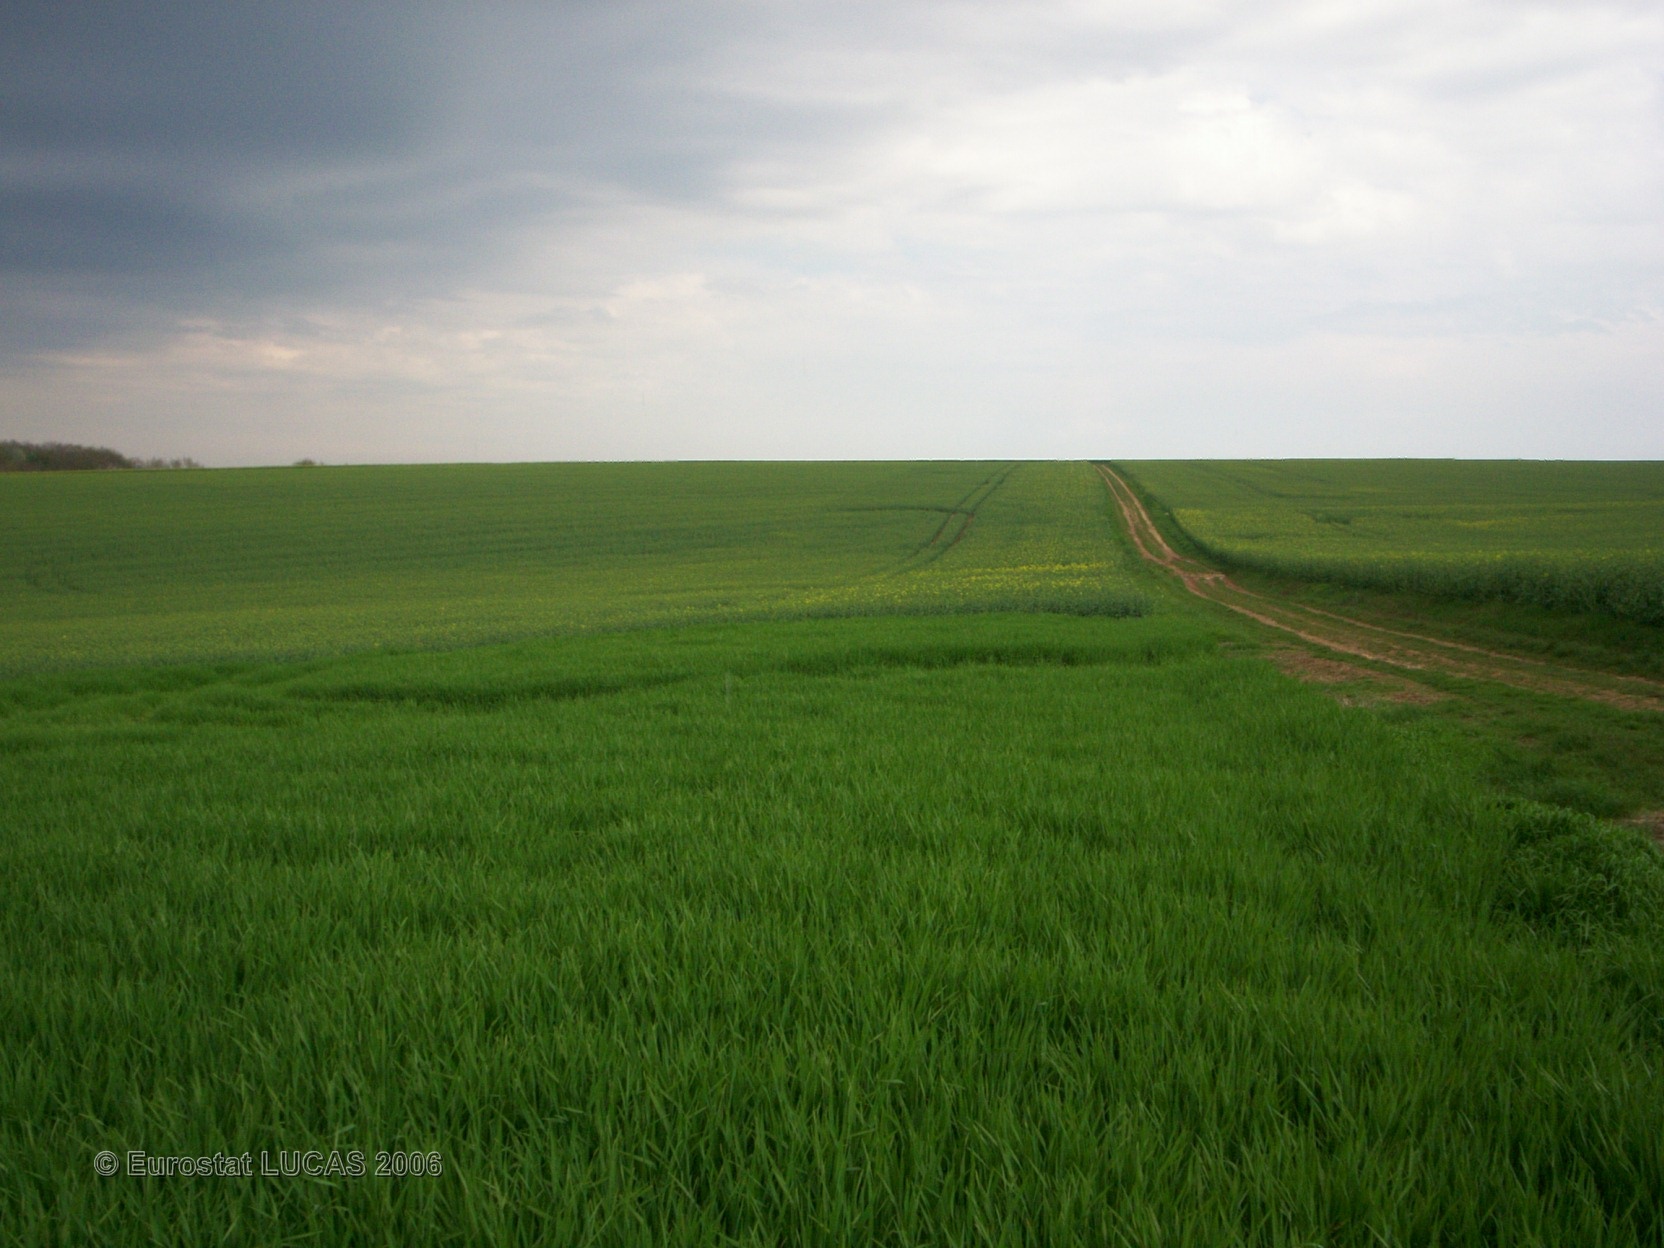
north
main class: Cropland
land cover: Barley
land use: Agriculture (excluding fallow land and kitchen gardens)
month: April
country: FR
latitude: 47.3910
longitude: 3.0662
